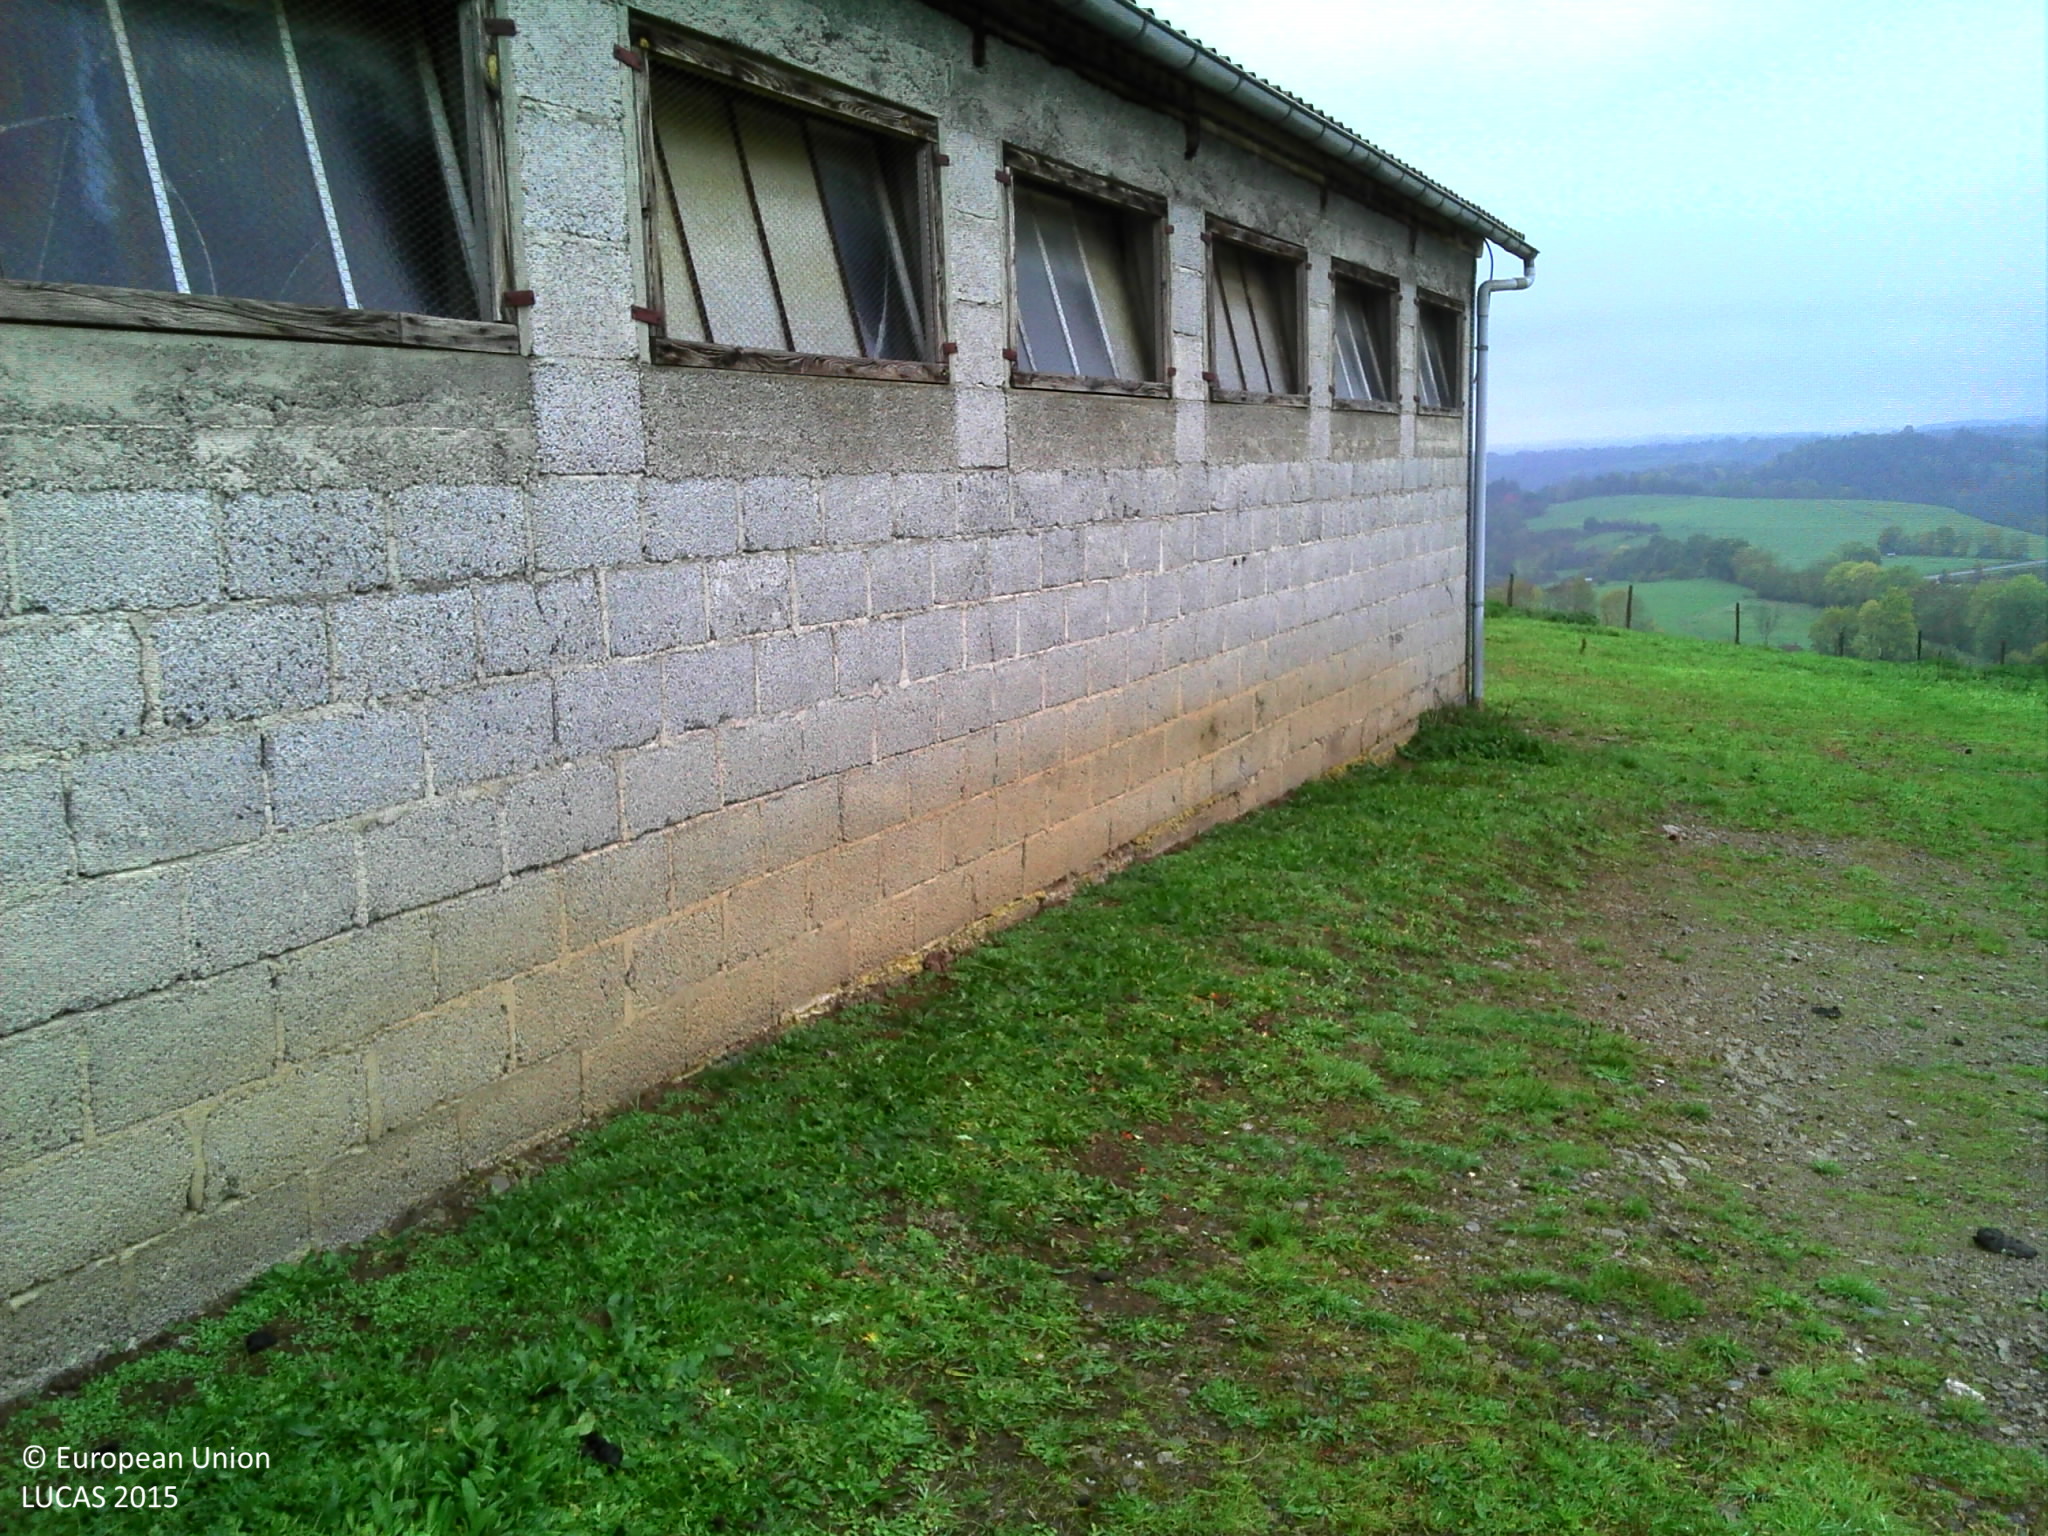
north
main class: Grassland
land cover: Grassland without tree/shrub cover
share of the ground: > 75 %
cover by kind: herbaceous plants 85 %, unconsolidated bare surface 15 %
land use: Agriculture (excluding fallow land and kitchen gardens)
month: October
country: FR
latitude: 45.7477
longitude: 2.8134
